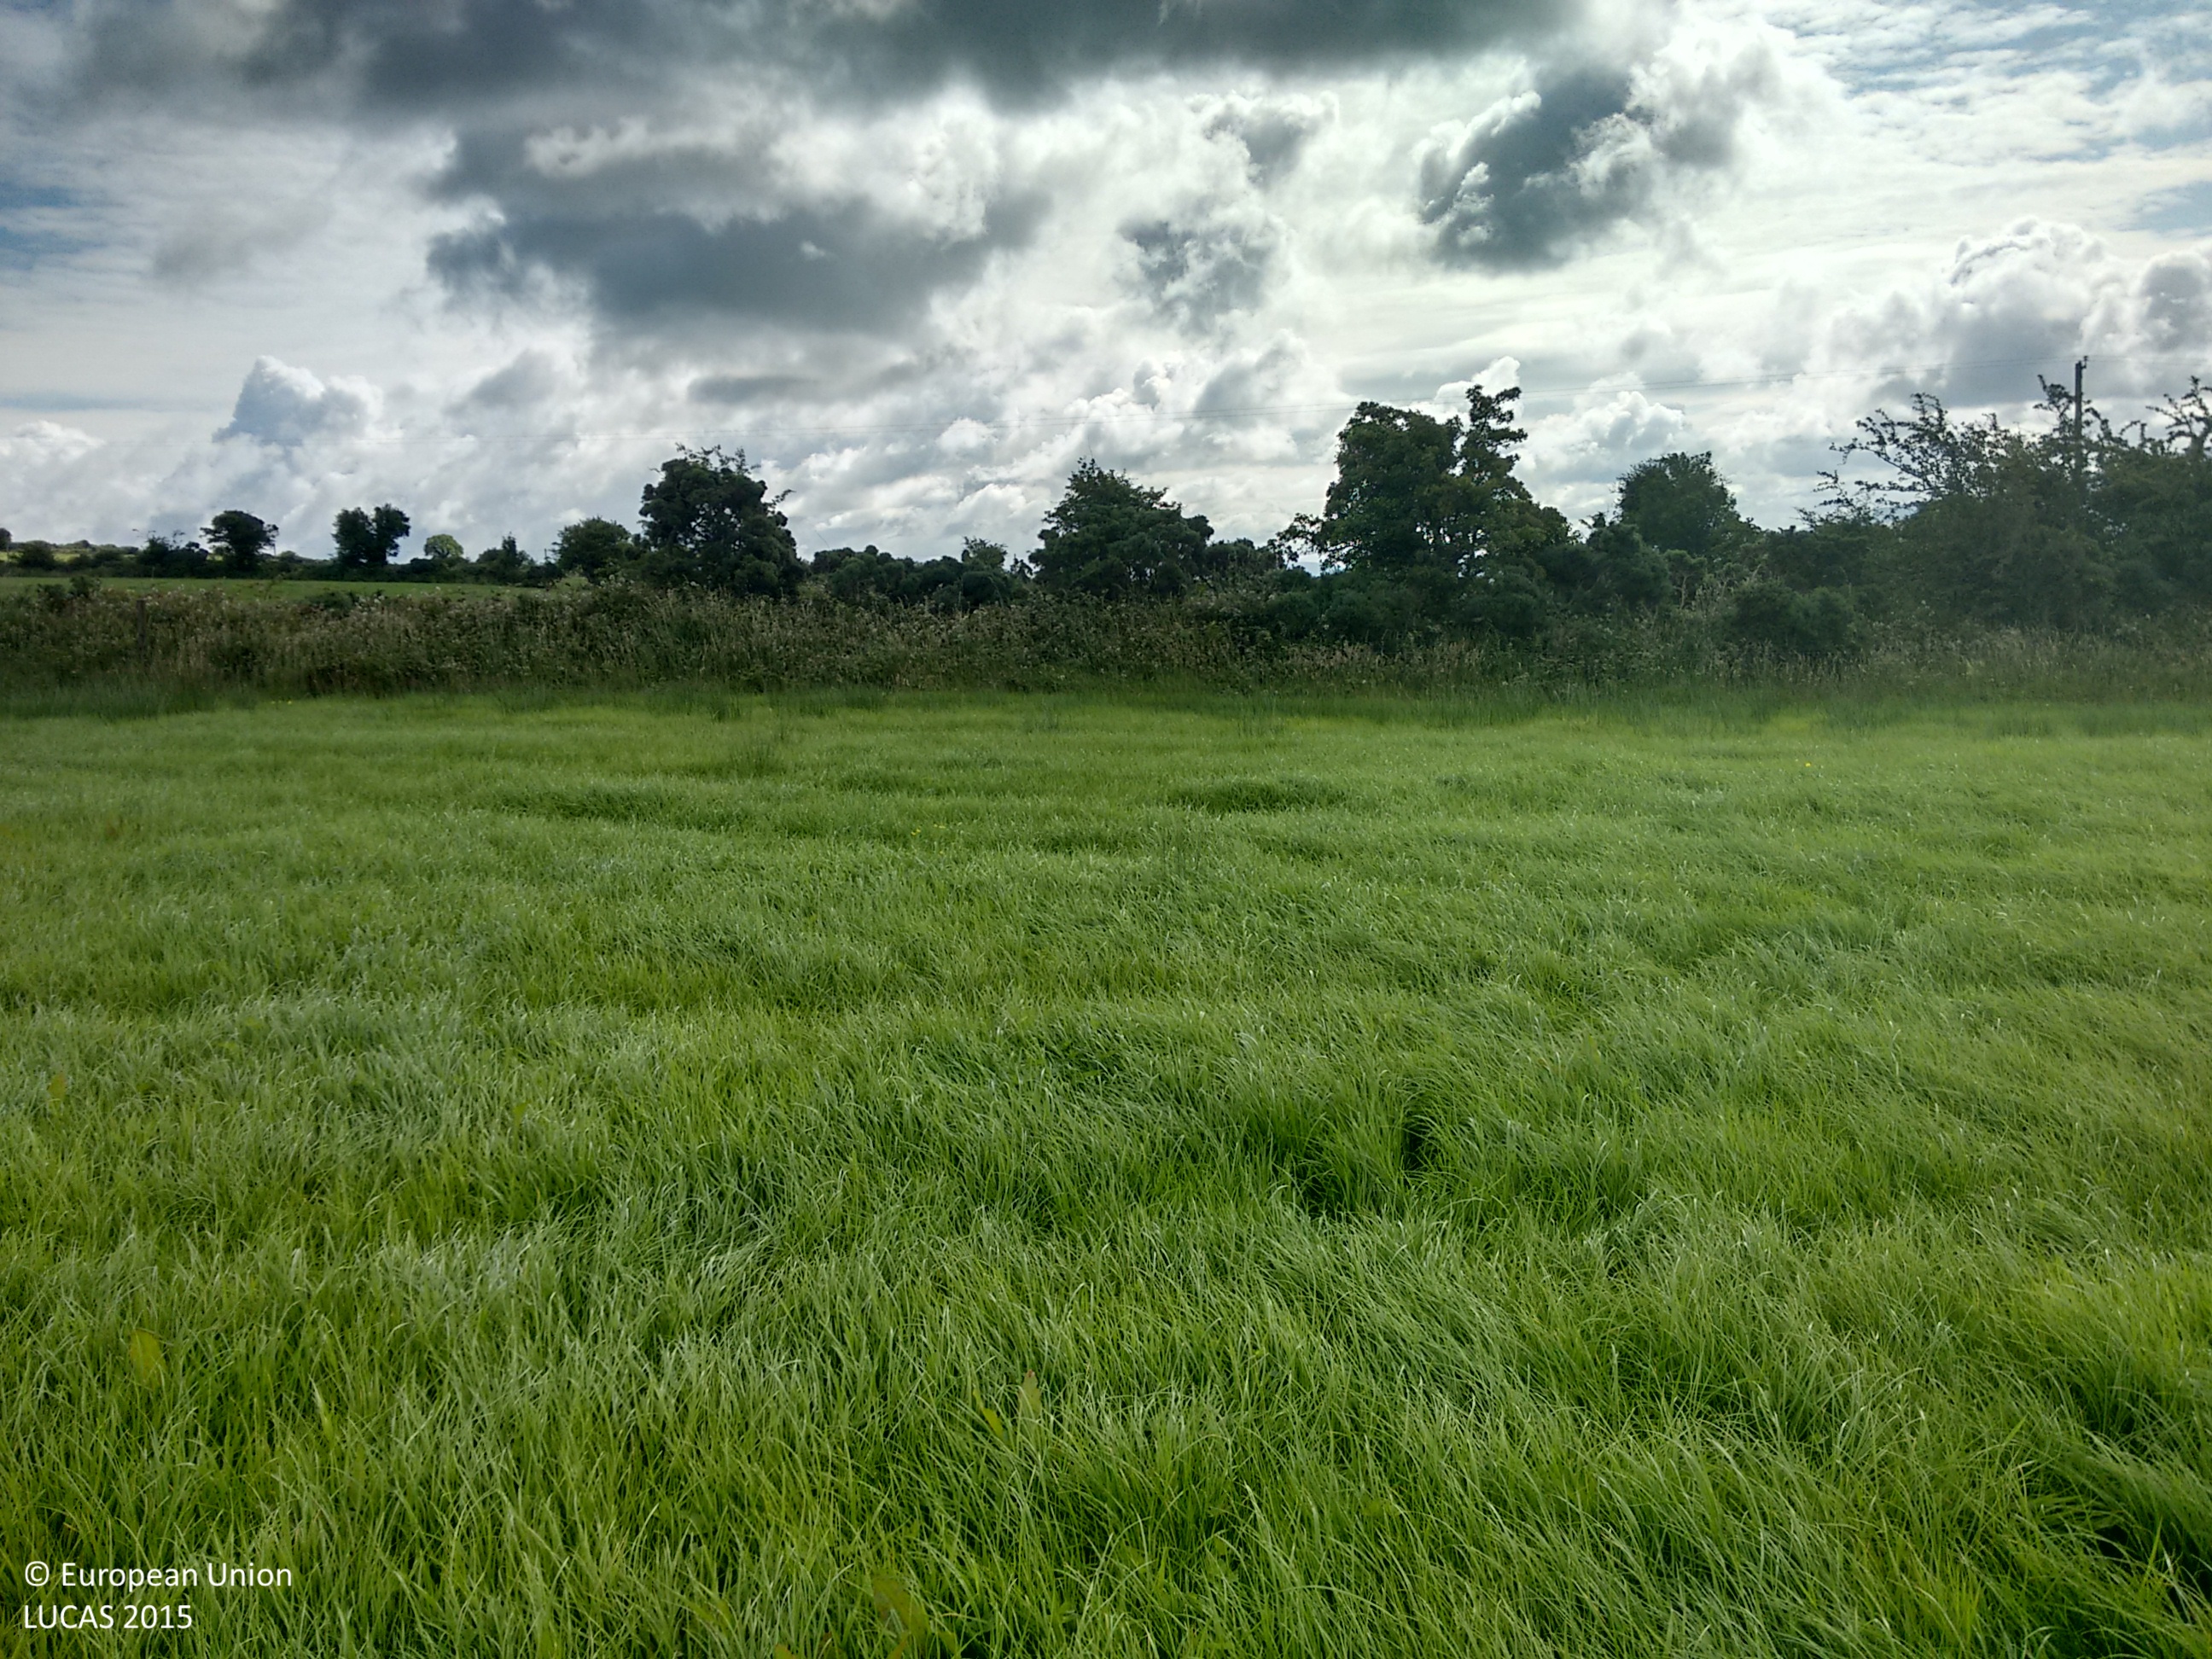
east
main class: Grassland
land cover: Grassland without tree/shrub cover
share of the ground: > 75 %
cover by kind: herbaceous plants 100 %
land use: Agriculture (excluding fallow land and kitchen gardens)
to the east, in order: Grassland without tree/shrub cover; Fences; Abandoned hedges; Grassland without tree/shrub cover; Electric lines; Grassland without tree/shrub cover; Abandoned hedges; Fences; Grassland without tree/shrub cover
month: July
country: IE
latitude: 52.8106
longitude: -8.3625
